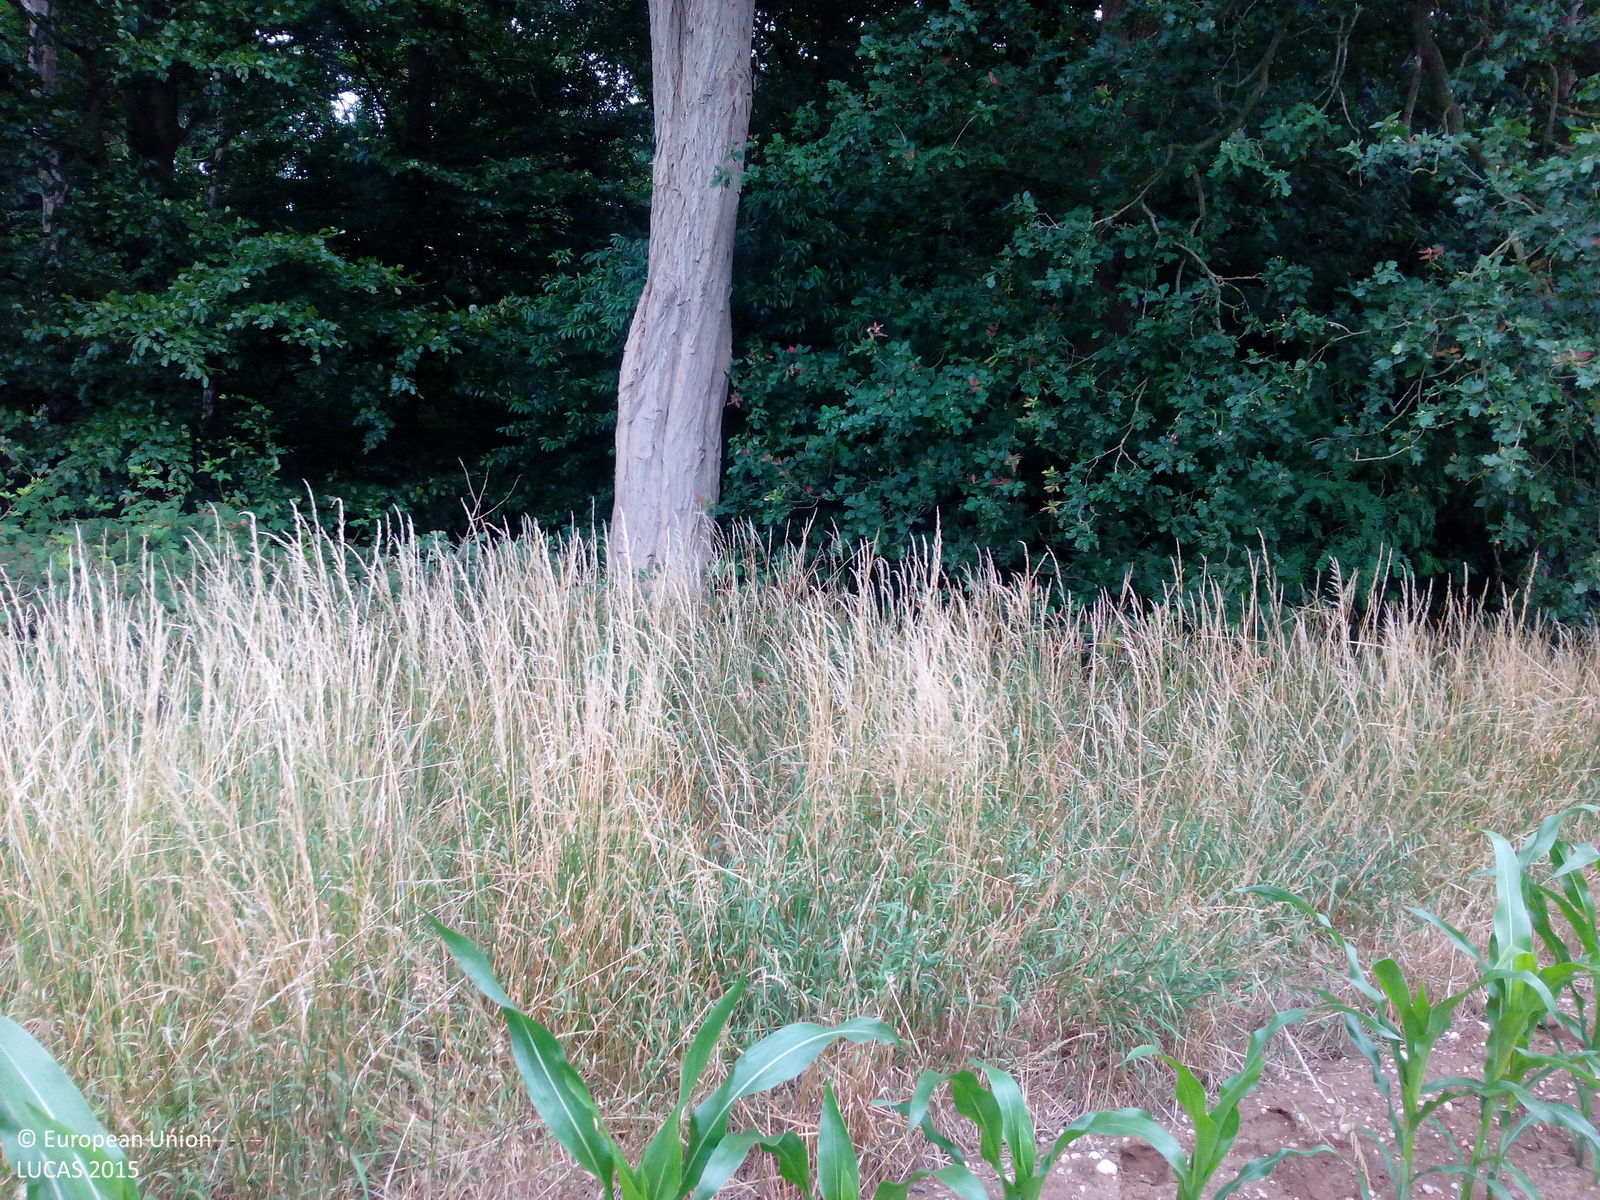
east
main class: Cropland
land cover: Maize
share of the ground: > 75 %
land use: Agriculture (excluding fallow land and kitchen gardens)
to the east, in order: Maize; Grass margins; Broadleaved woodland; Tracks; Other mixed woodland; Tracks; Other mixed woodland; Tracks; Other mixed woodland
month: July
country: NL
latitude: 51.8860
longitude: 6.2364
